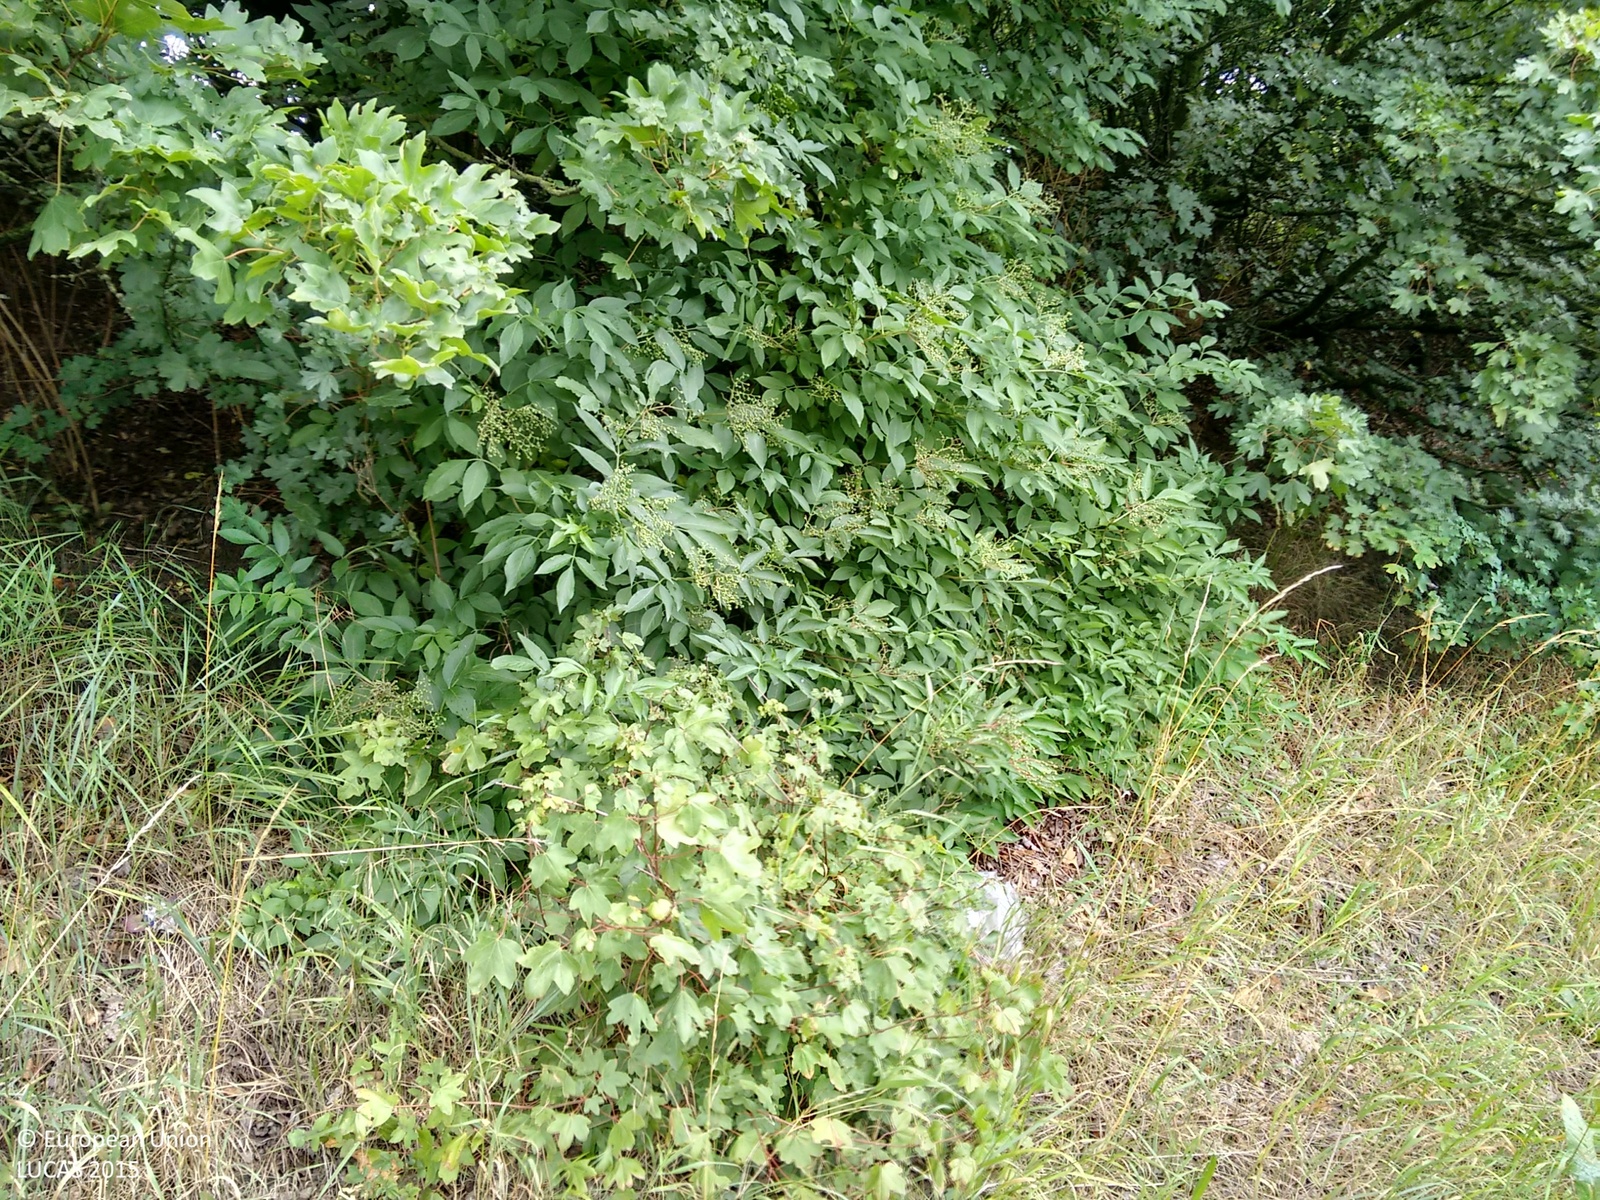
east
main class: Woodland
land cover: Broadleaved woodland
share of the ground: > 75 %
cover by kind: broadleaved forest trees 75 %, herbaceous plants 25 %
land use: Forestry
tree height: < 5 m
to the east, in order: Broadleaved woodland; Artificial constructions in urban areas; Common wheat; Electric lines; Common wheat
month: July
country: GB
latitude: 52.7788
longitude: 0.1103
